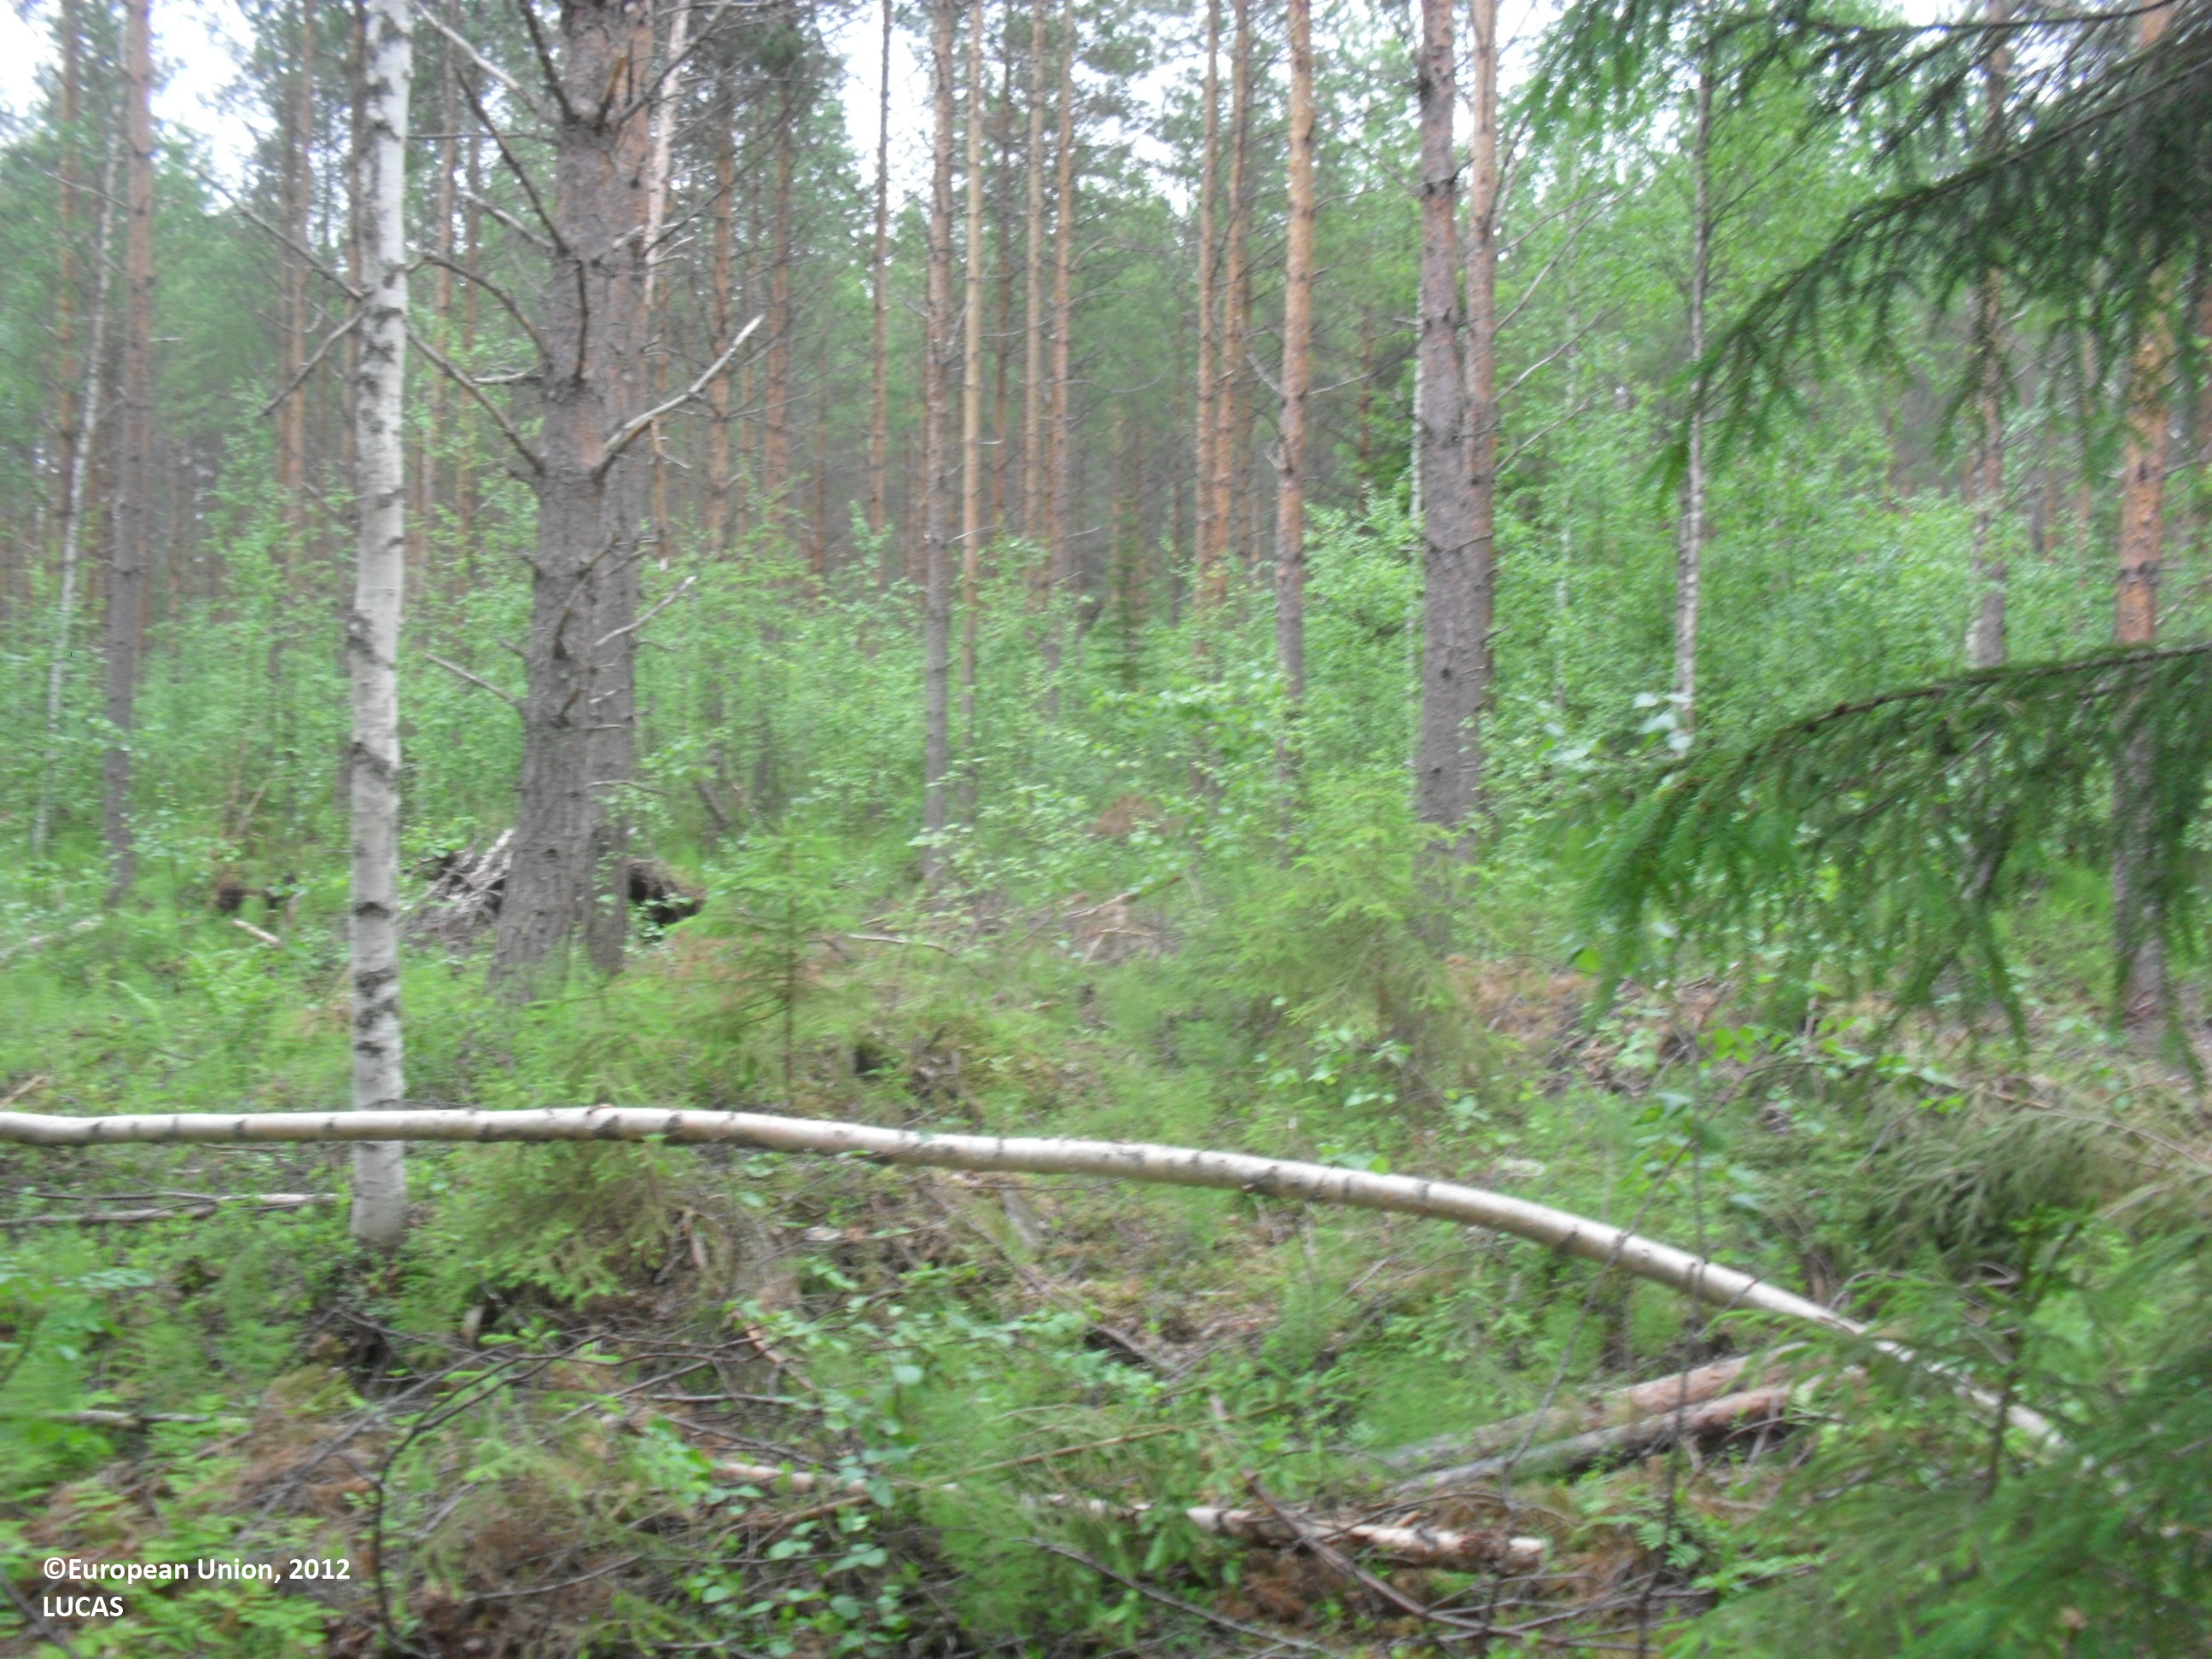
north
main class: Woodland
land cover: Other mixed woodland
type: boreal forest
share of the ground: 50 - 75 %
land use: Forestry
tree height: > 5 m
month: June
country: FI
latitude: 62.9804
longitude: 23.6237
